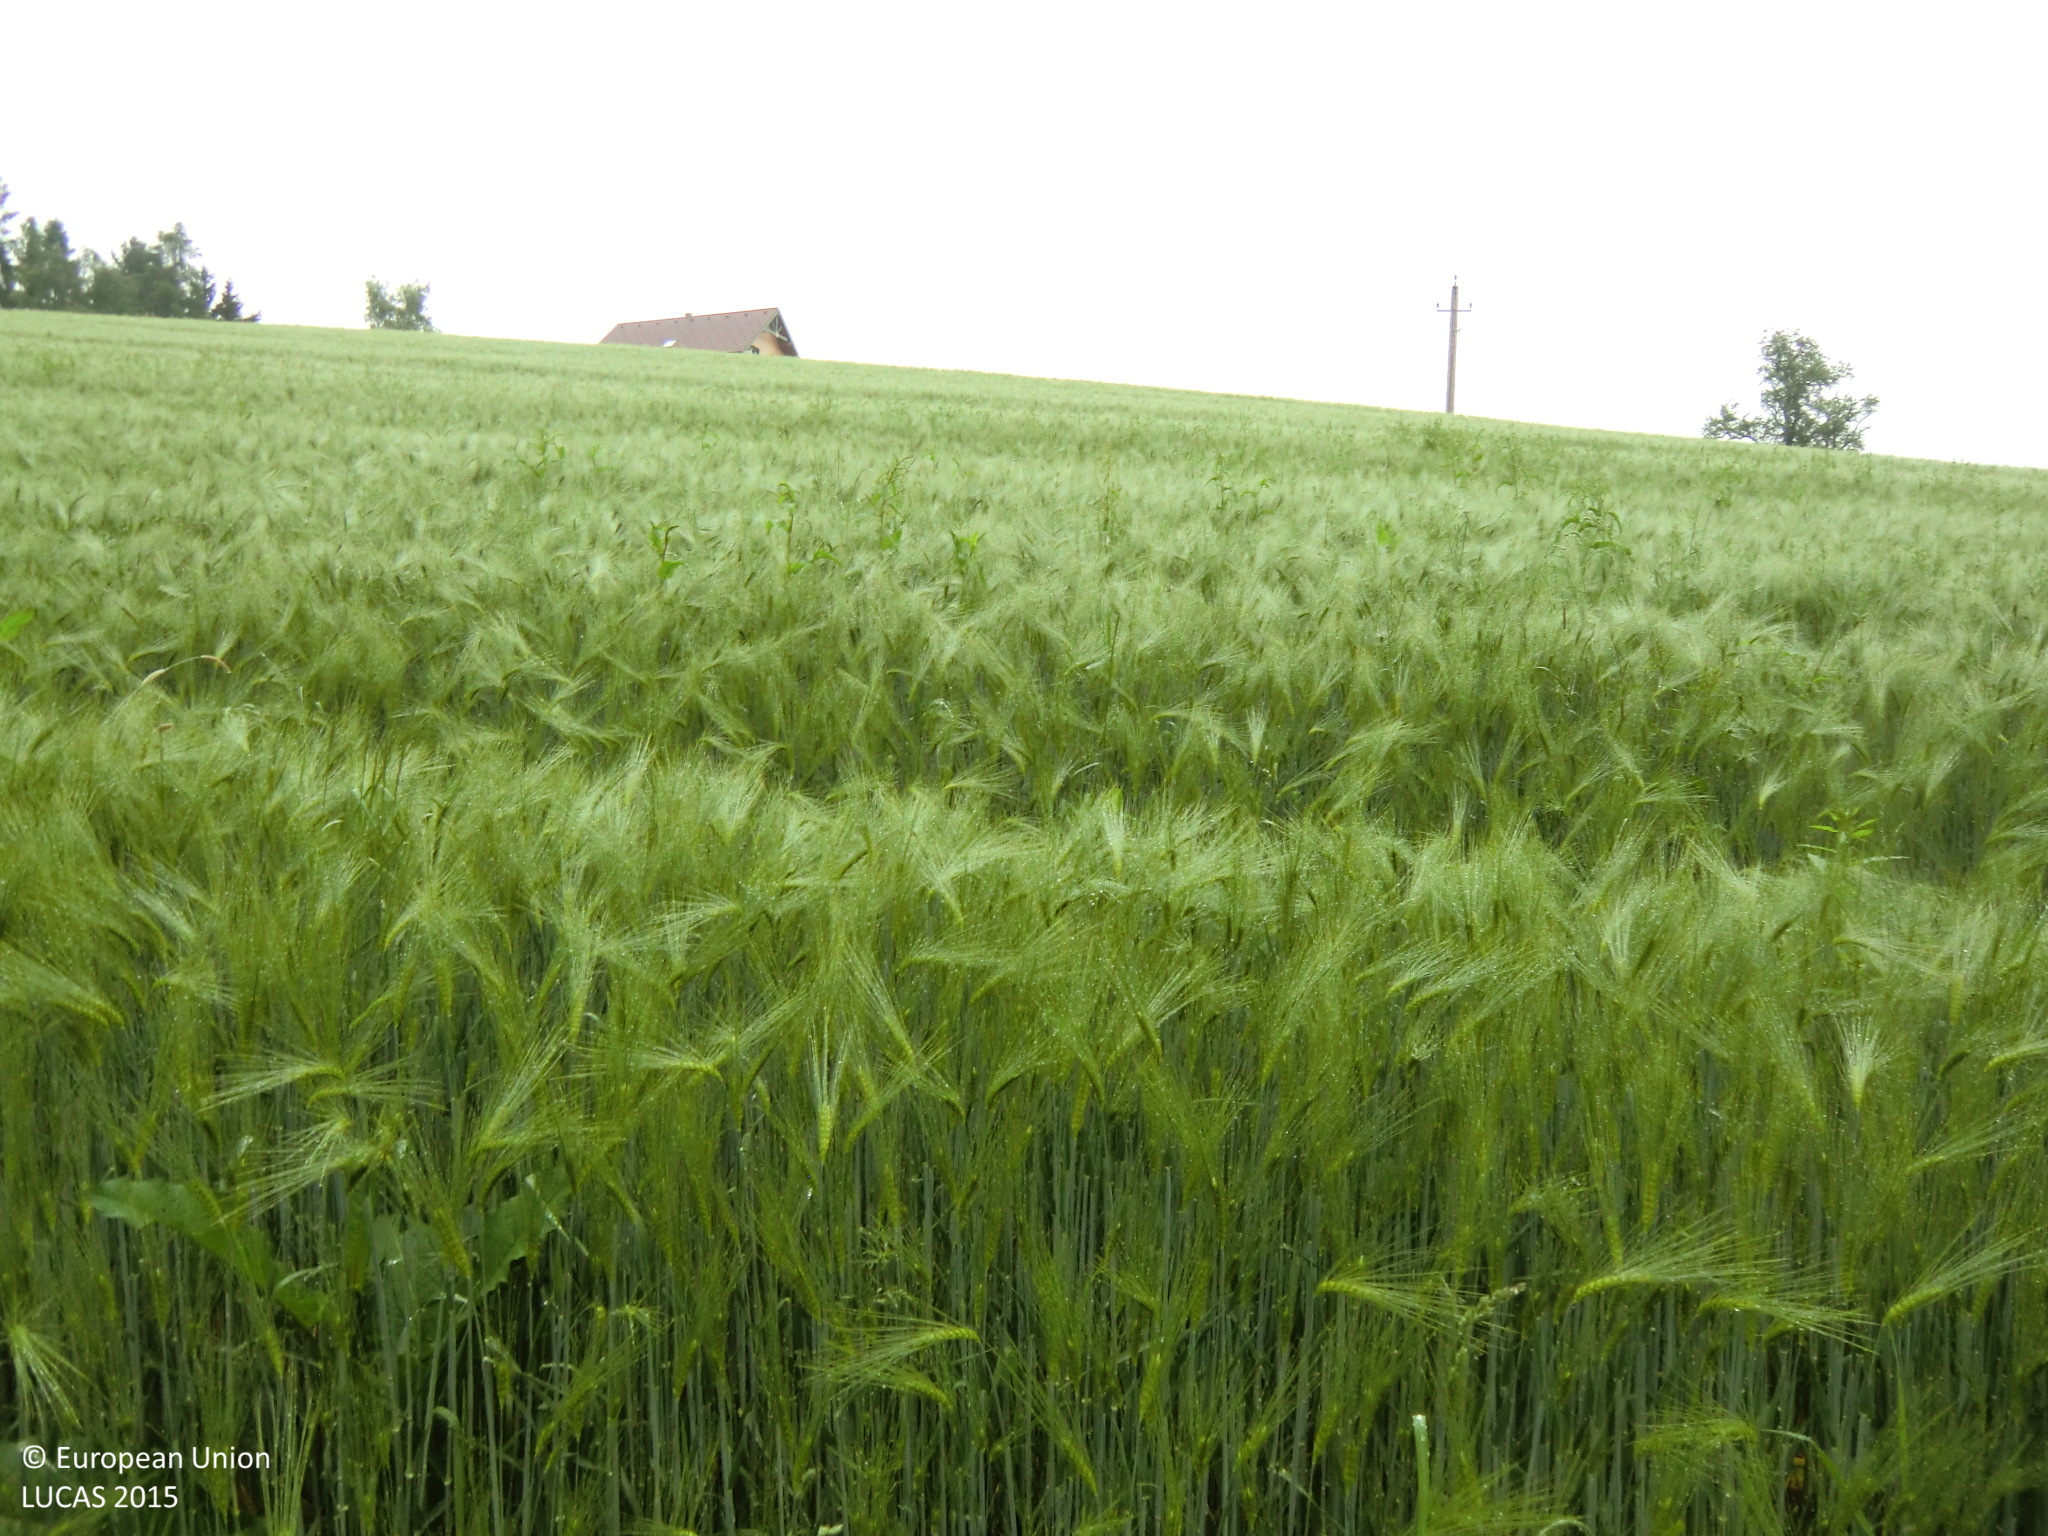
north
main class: Grassland
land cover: Grassland without tree/shrub cover
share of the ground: > 75 %
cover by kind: herbaceous plants 100 %
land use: Agriculture (excluding fallow land and kitchen gardens)
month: May
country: AT
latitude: 48.3101
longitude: 14.5444
